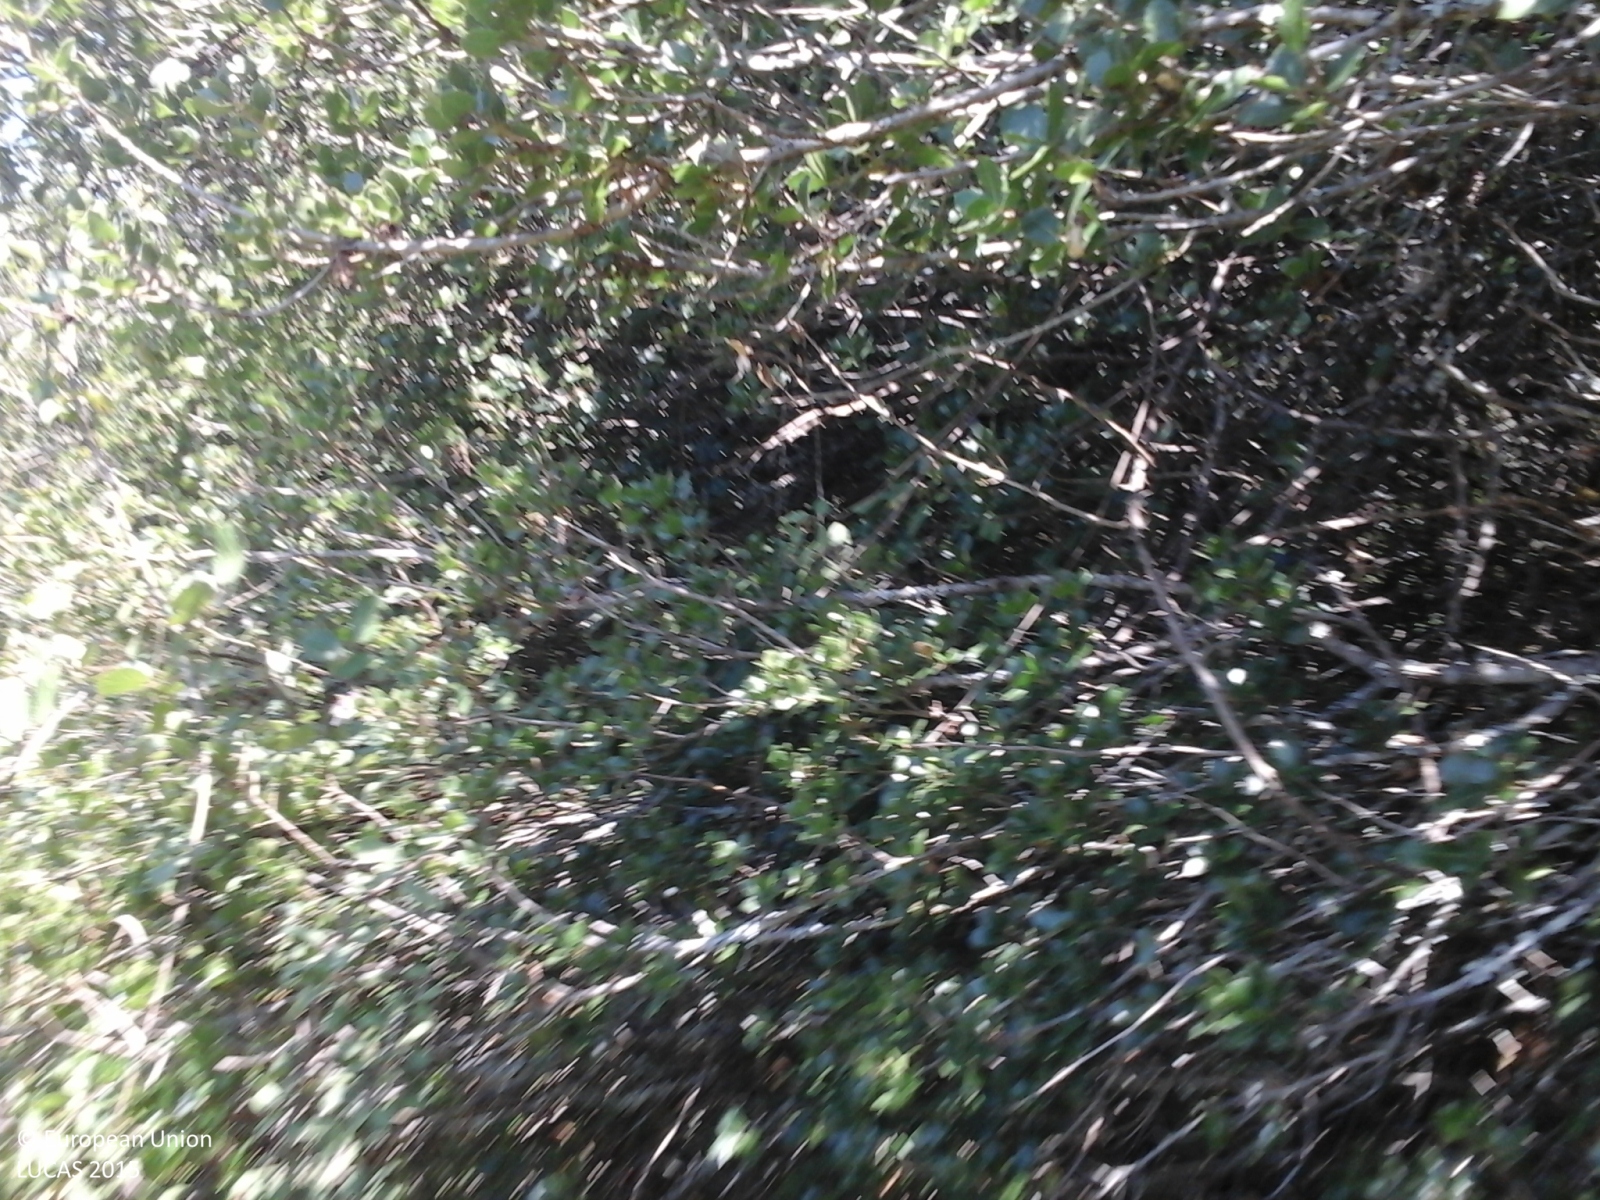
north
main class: Shrubland
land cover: Shrubland with sparse tree cover
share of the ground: > 75 %
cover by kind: shrubs 75 %, herbaceous plants 20 %, broadleaved forest trees 5 %
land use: Agriculture (excluding fallow land and kitchen gardens)
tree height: > 5 m
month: July
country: GR
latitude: 39.4381
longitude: 20.9095
